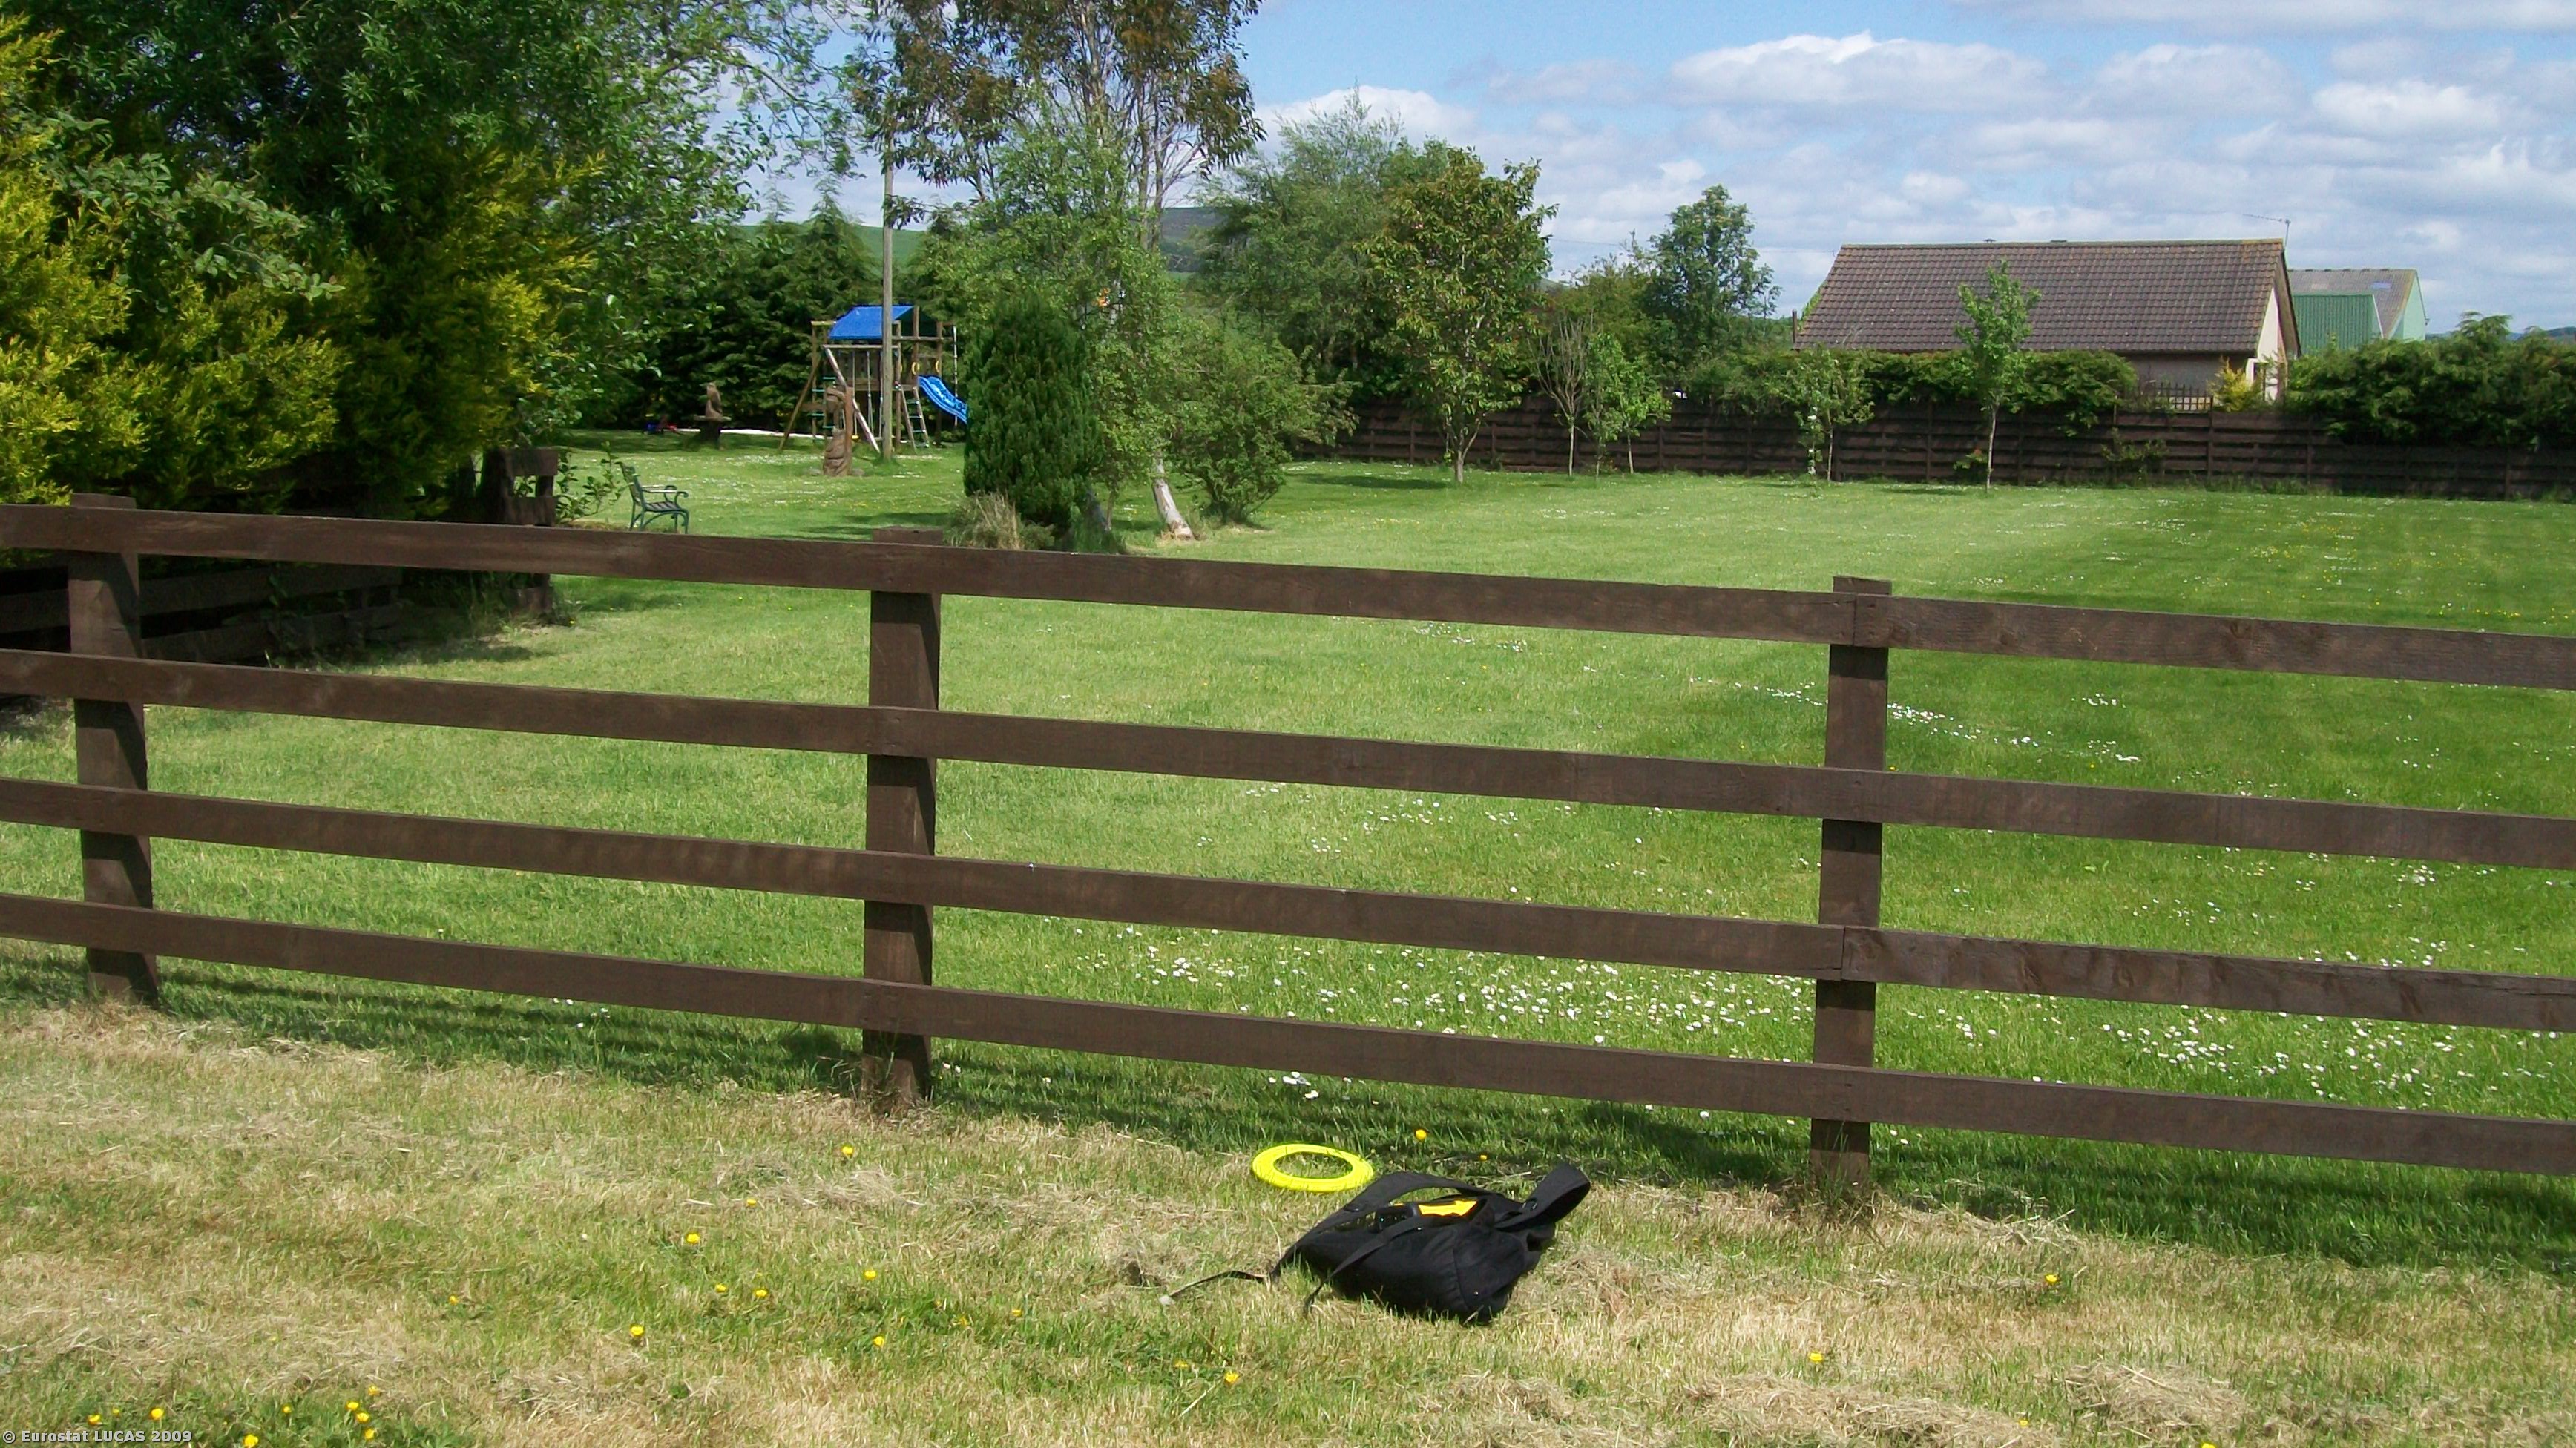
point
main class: Artificial land
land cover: Non built-up area features
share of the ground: > 75 %
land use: Residential
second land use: Agriculture (excluding fallow land and kitchen gardens)
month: June
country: GB
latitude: 55.6693
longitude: -3.5134
